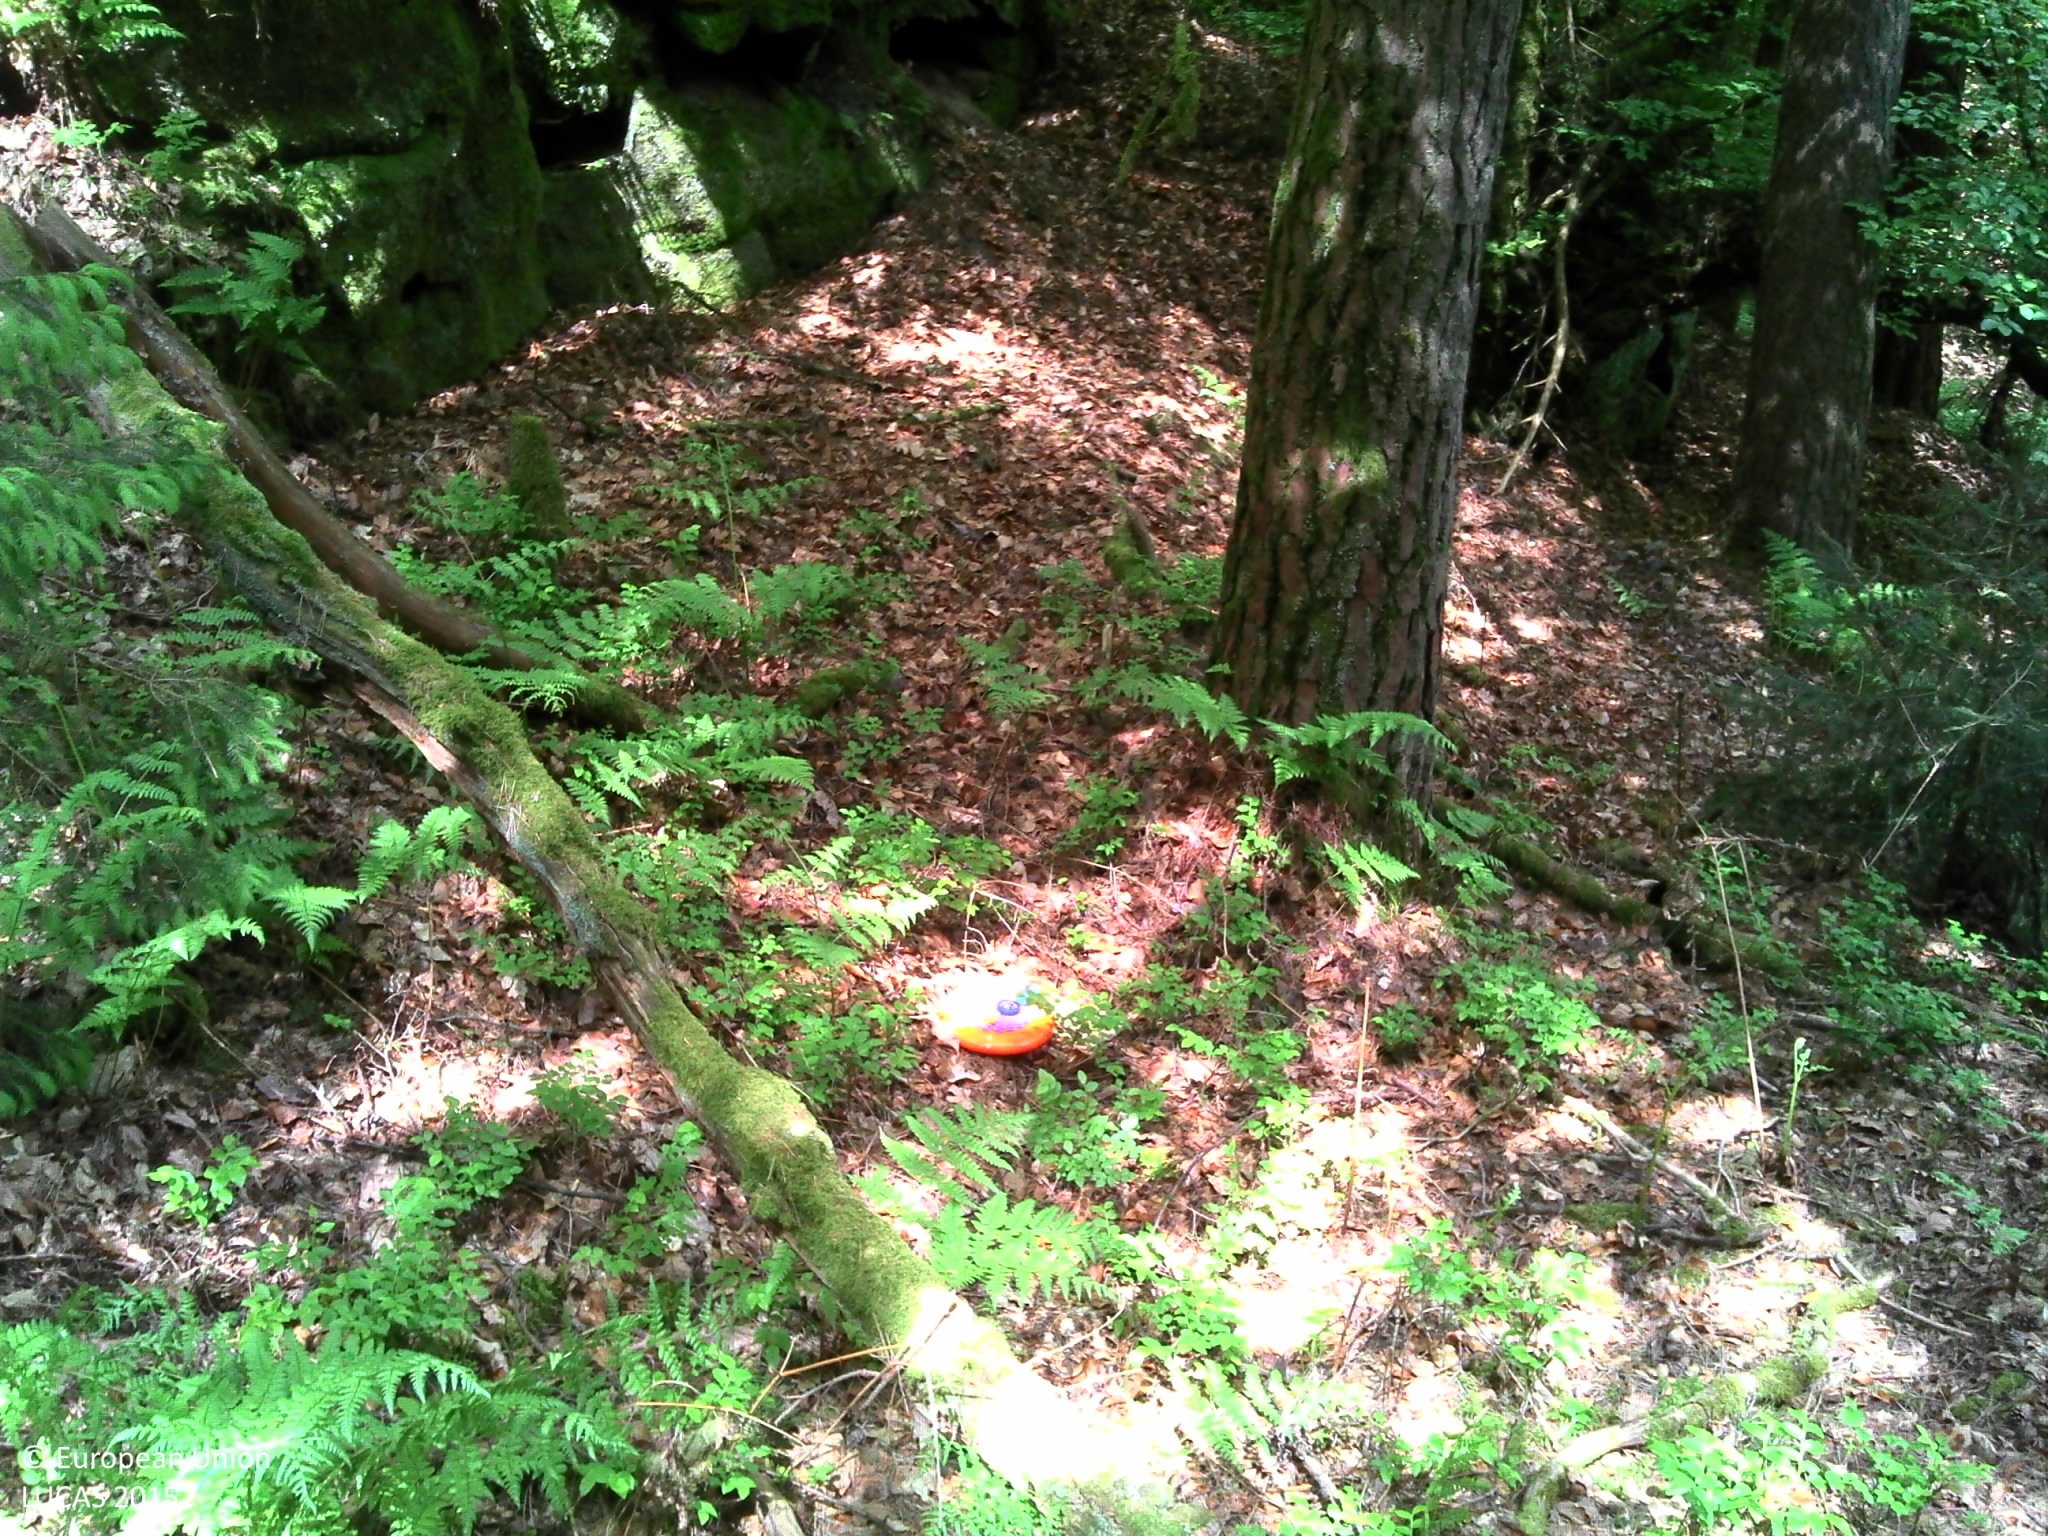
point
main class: Woodland
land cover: Spruce dominated mixed woodland
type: alpine coniferous forest
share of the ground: > 75 %
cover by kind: coniferous forest trees 65 %, broadleaved forest trees 25 %, herbaceous plants 5 %, lichens and mosses 5 %
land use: Forestry
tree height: > 5 m
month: May
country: LU
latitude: 49.7460
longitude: 6.2942
